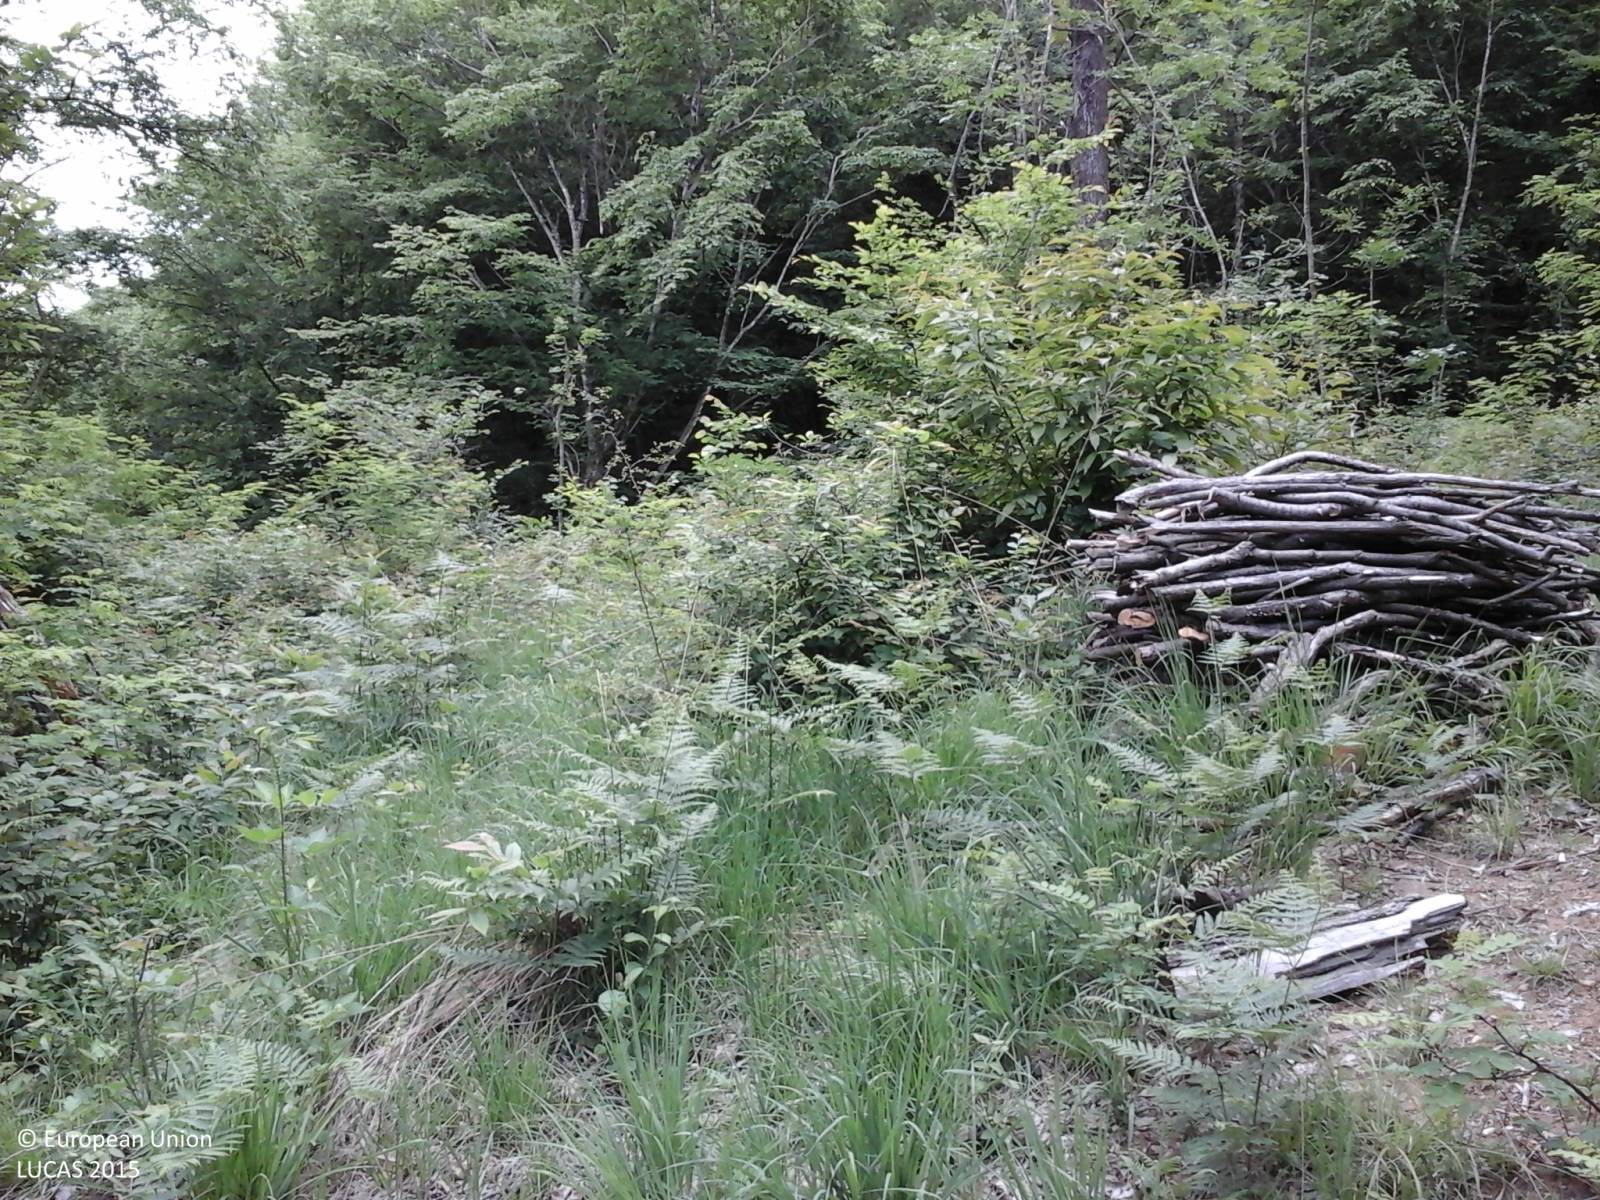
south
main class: Woodland
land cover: Broadleaved woodland
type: mesophytic deciduous forest
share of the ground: > 75 %
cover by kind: broadleaved forest trees 85 %, shrubs 10 %, herbaceous plants 5 %
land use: Forestry
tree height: > 5 m
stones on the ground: 25 - 50 %
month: May
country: IT
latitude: 46.1749
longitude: 13.2737
